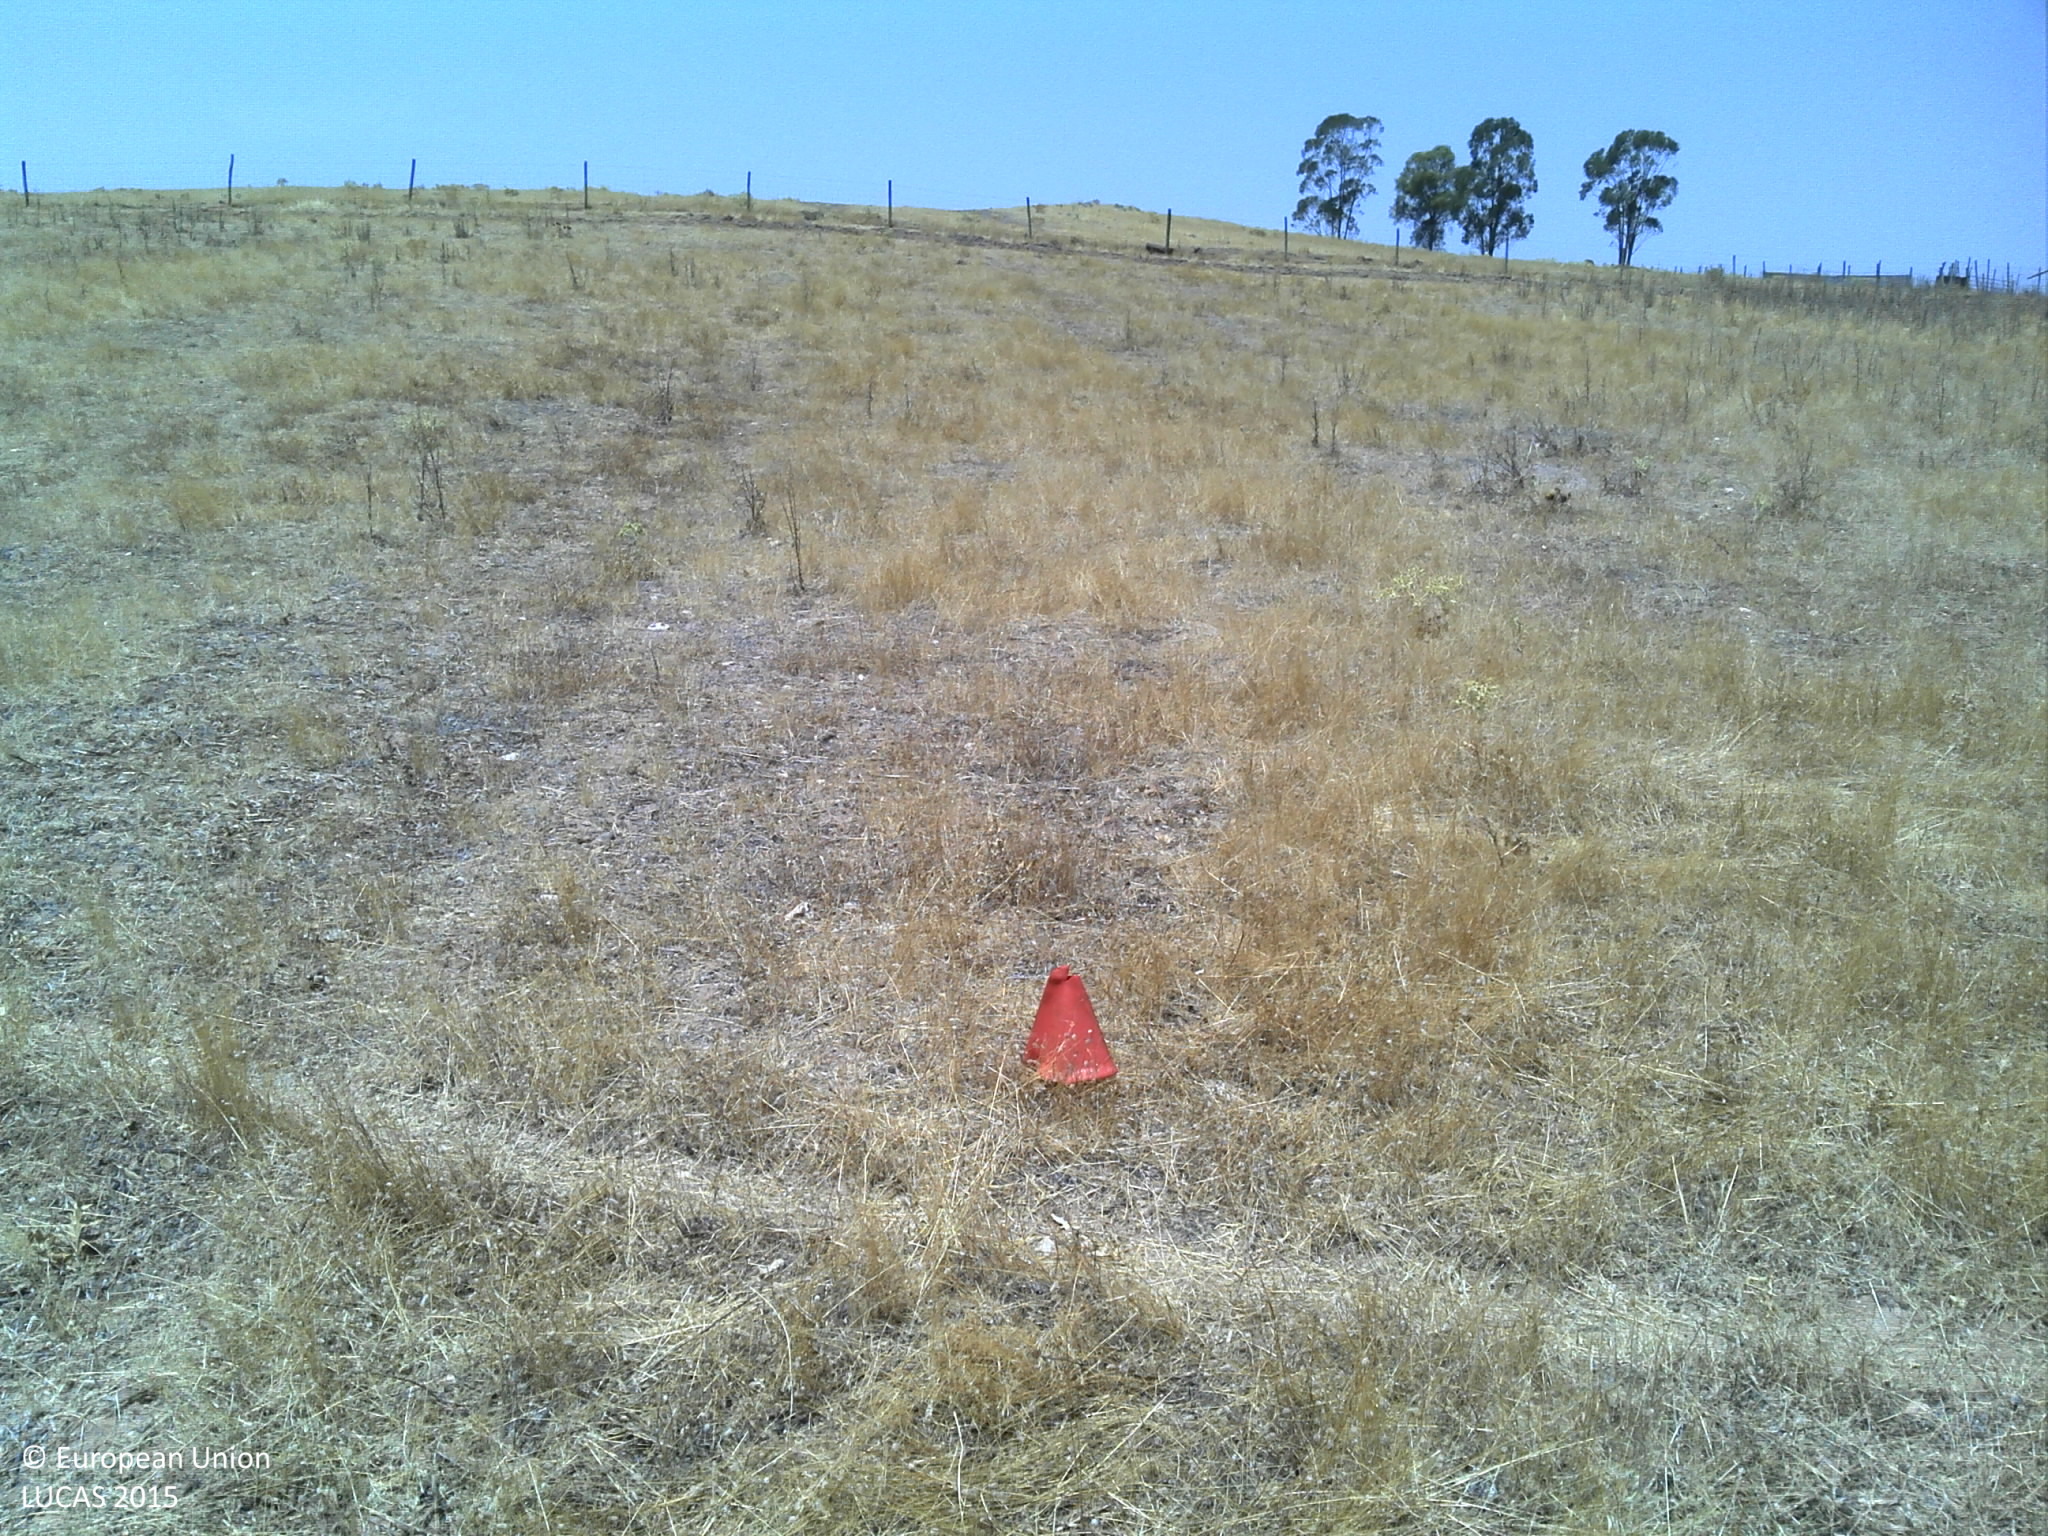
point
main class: Grassland
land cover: Grassland without tree/shrub cover
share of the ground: 10 - 25 %
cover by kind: unconsolidated bare surface 75 %, herbaceous plants 25 %
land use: Agriculture (excluding fallow land and kitchen gardens)
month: July
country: PT
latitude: 37.7018
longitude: -7.7929
